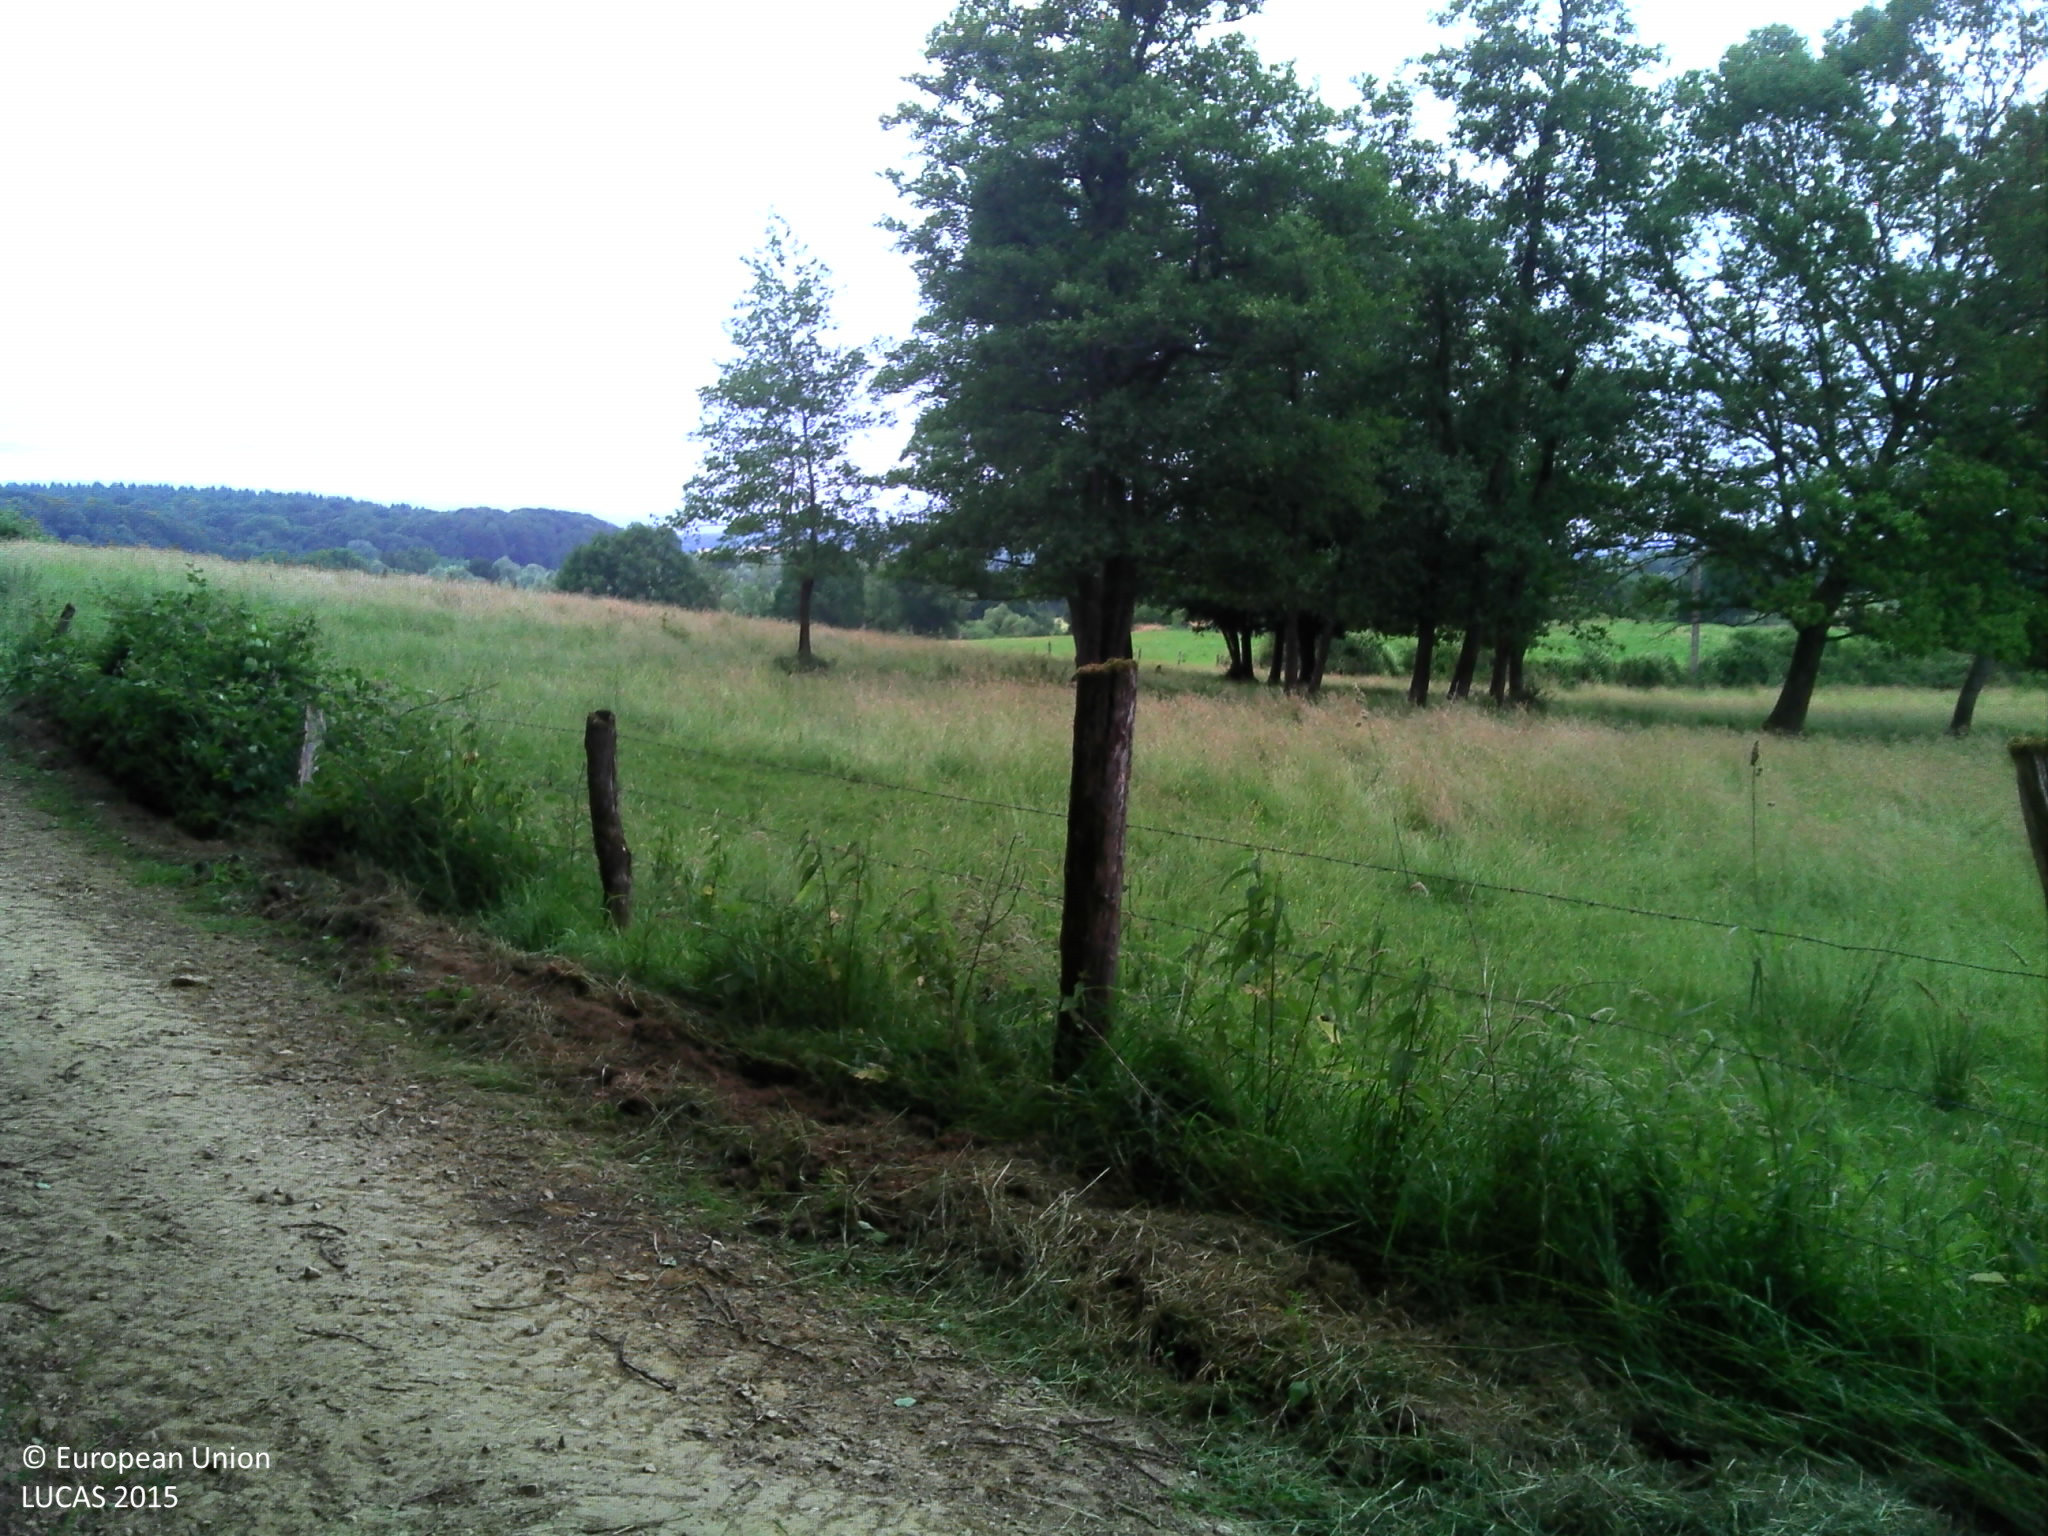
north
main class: Grassland
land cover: Grassland without tree/shrub cover
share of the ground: > 75 %
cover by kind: herbaceous plants 100 %
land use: Agriculture (excluding fallow land and kitchen gardens)
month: June
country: FR
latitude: 47.5155
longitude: 6.3763
